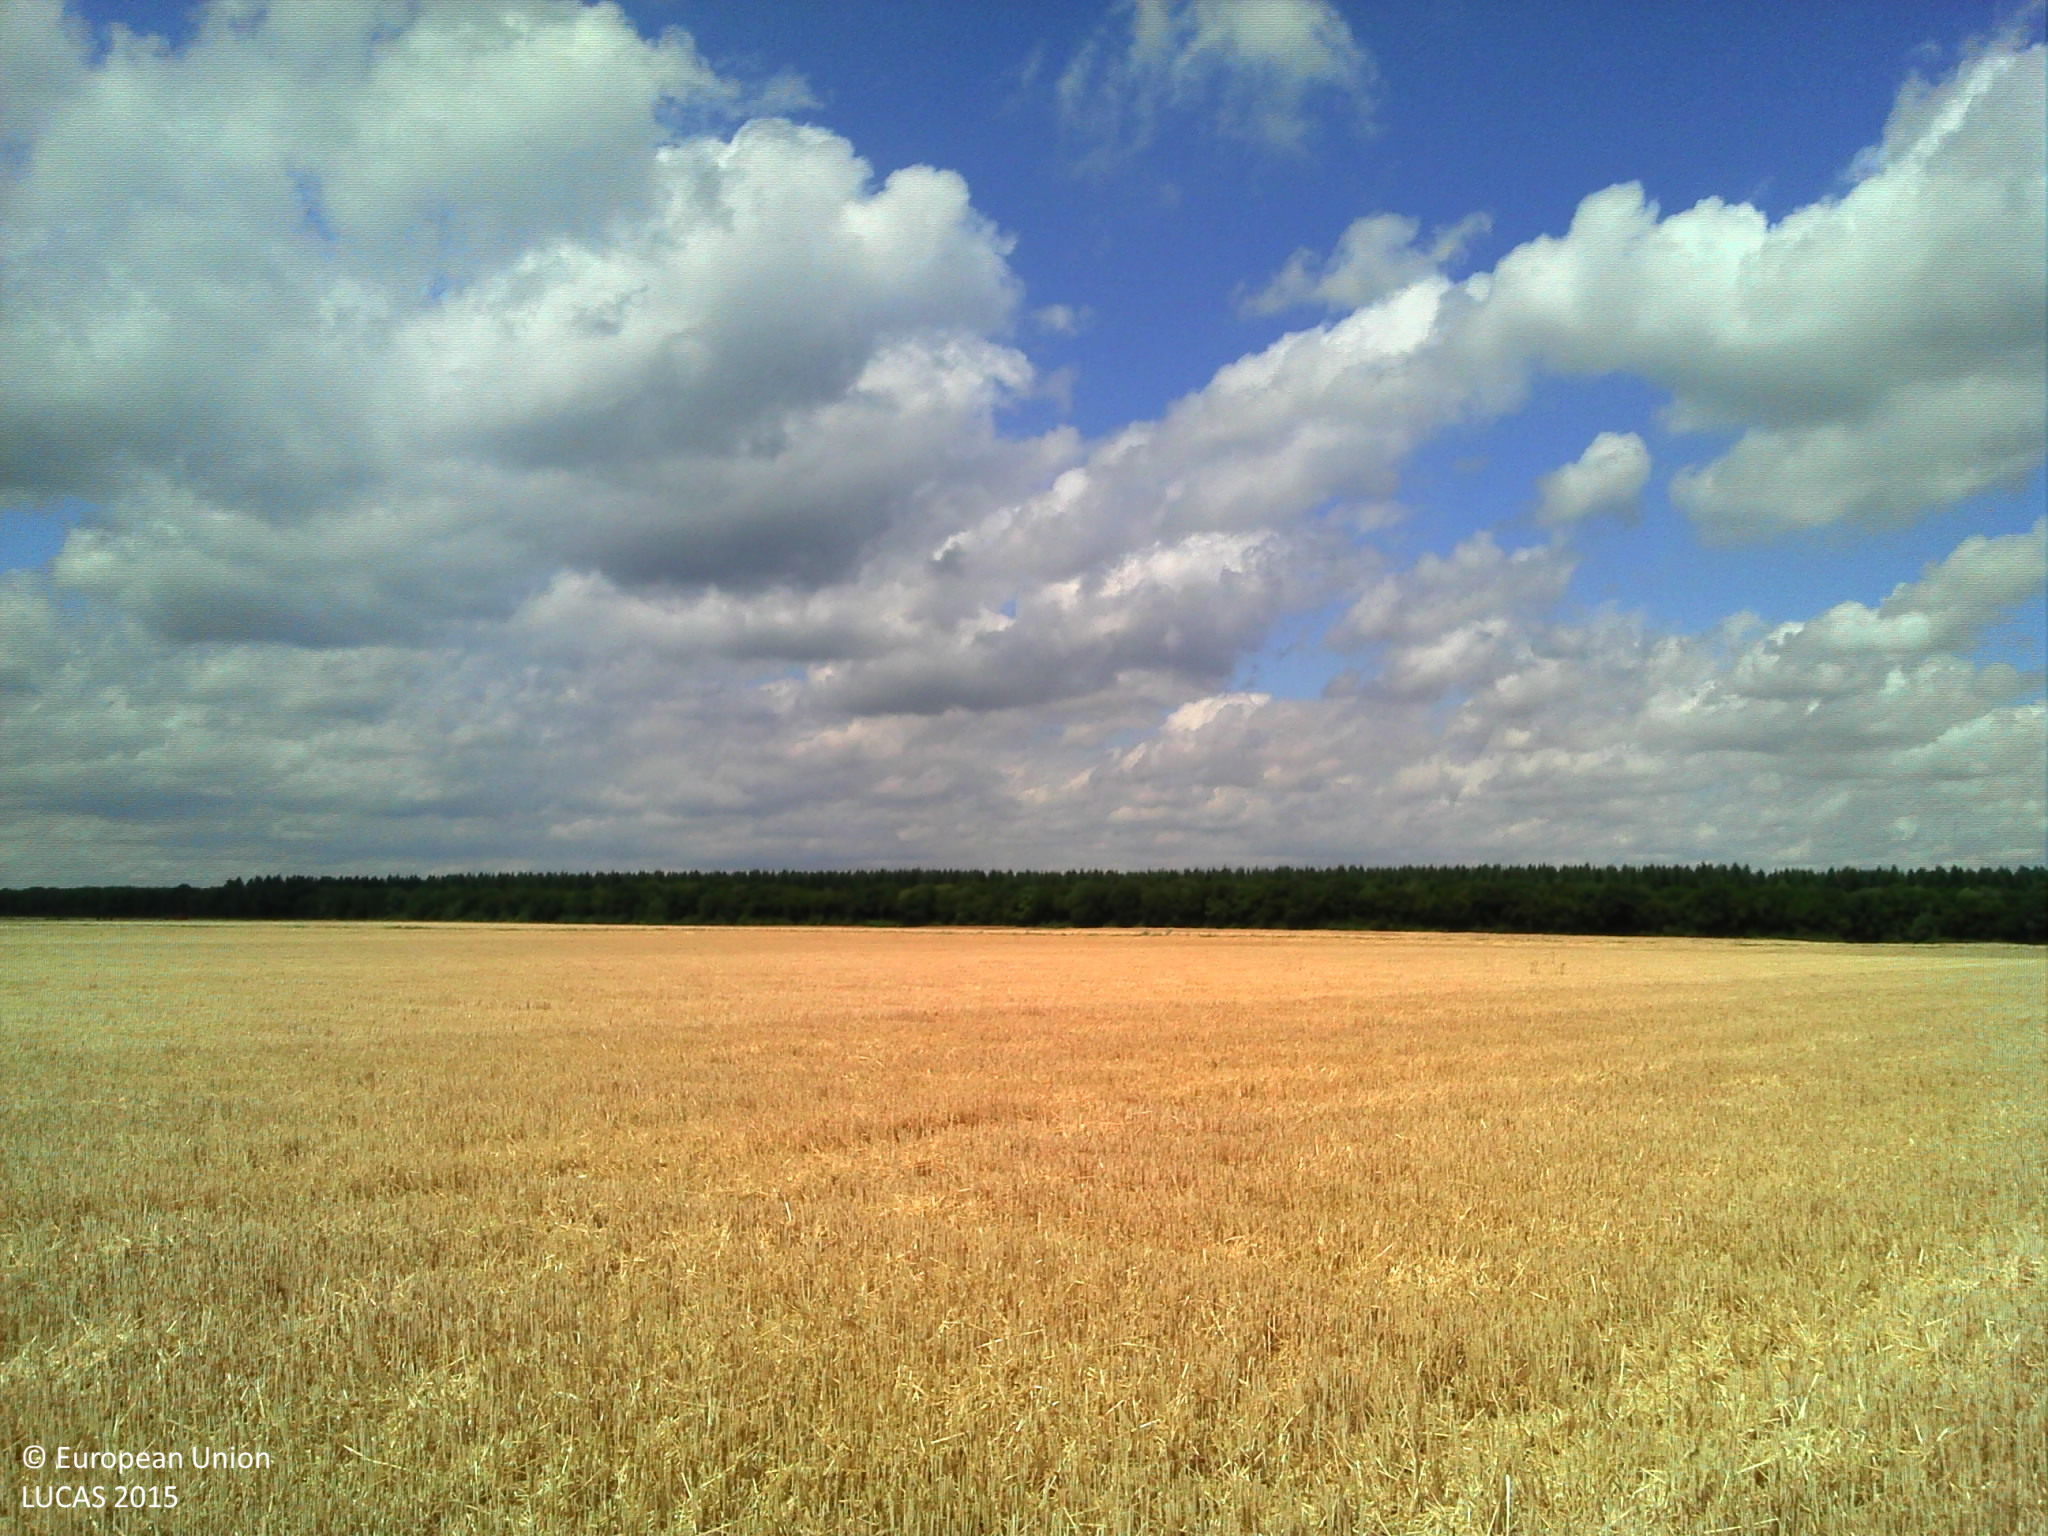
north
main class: Cropland
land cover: Common wheat
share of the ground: > 75 %
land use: Agriculture (excluding fallow land and kitchen gardens)
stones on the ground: < 10 %
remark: Harvested field
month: July
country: FR
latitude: 49.0988
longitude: 2.6619
